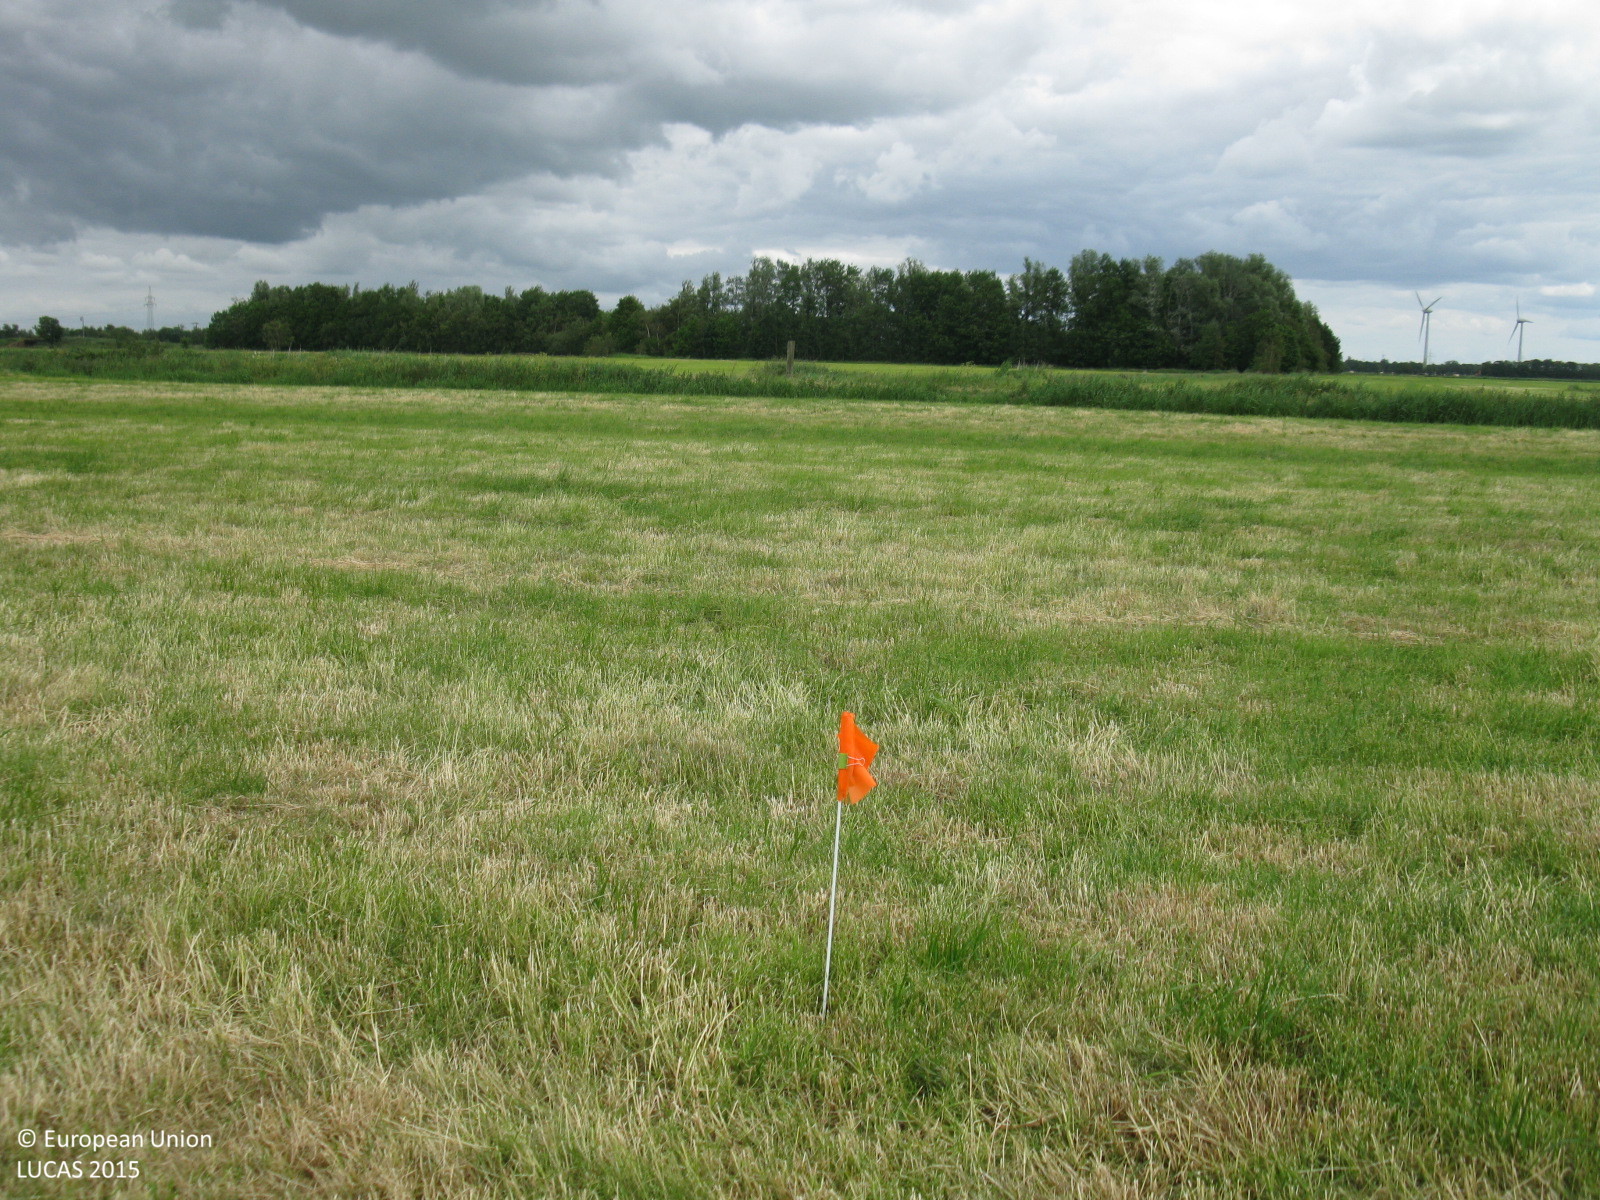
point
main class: Grassland
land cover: Grassland without tree/shrub cover
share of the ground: > 75 %
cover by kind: herbaceous plants 100 %
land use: Agriculture (excluding fallow land and kitchen gardens)
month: June
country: DE
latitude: 53.3195
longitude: 7.3735
